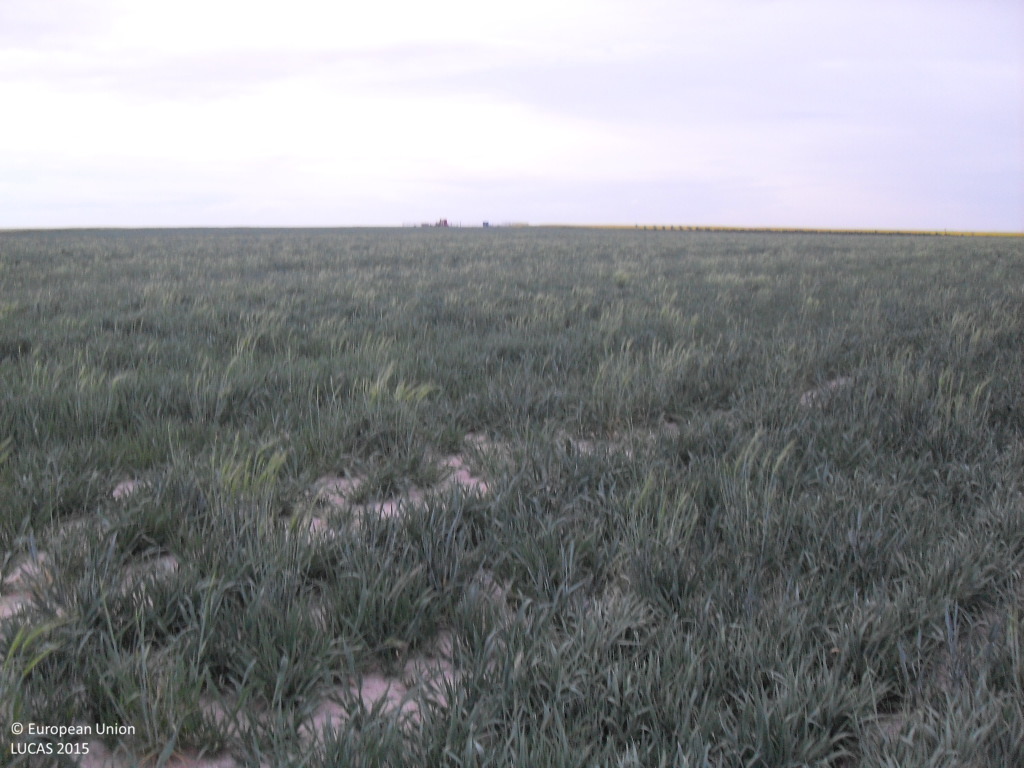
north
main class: Cropland
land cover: Oats
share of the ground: > 75 %
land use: Agriculture (excluding fallow land and kitchen gardens)
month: April
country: ES
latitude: 40.9781
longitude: -5.2461
